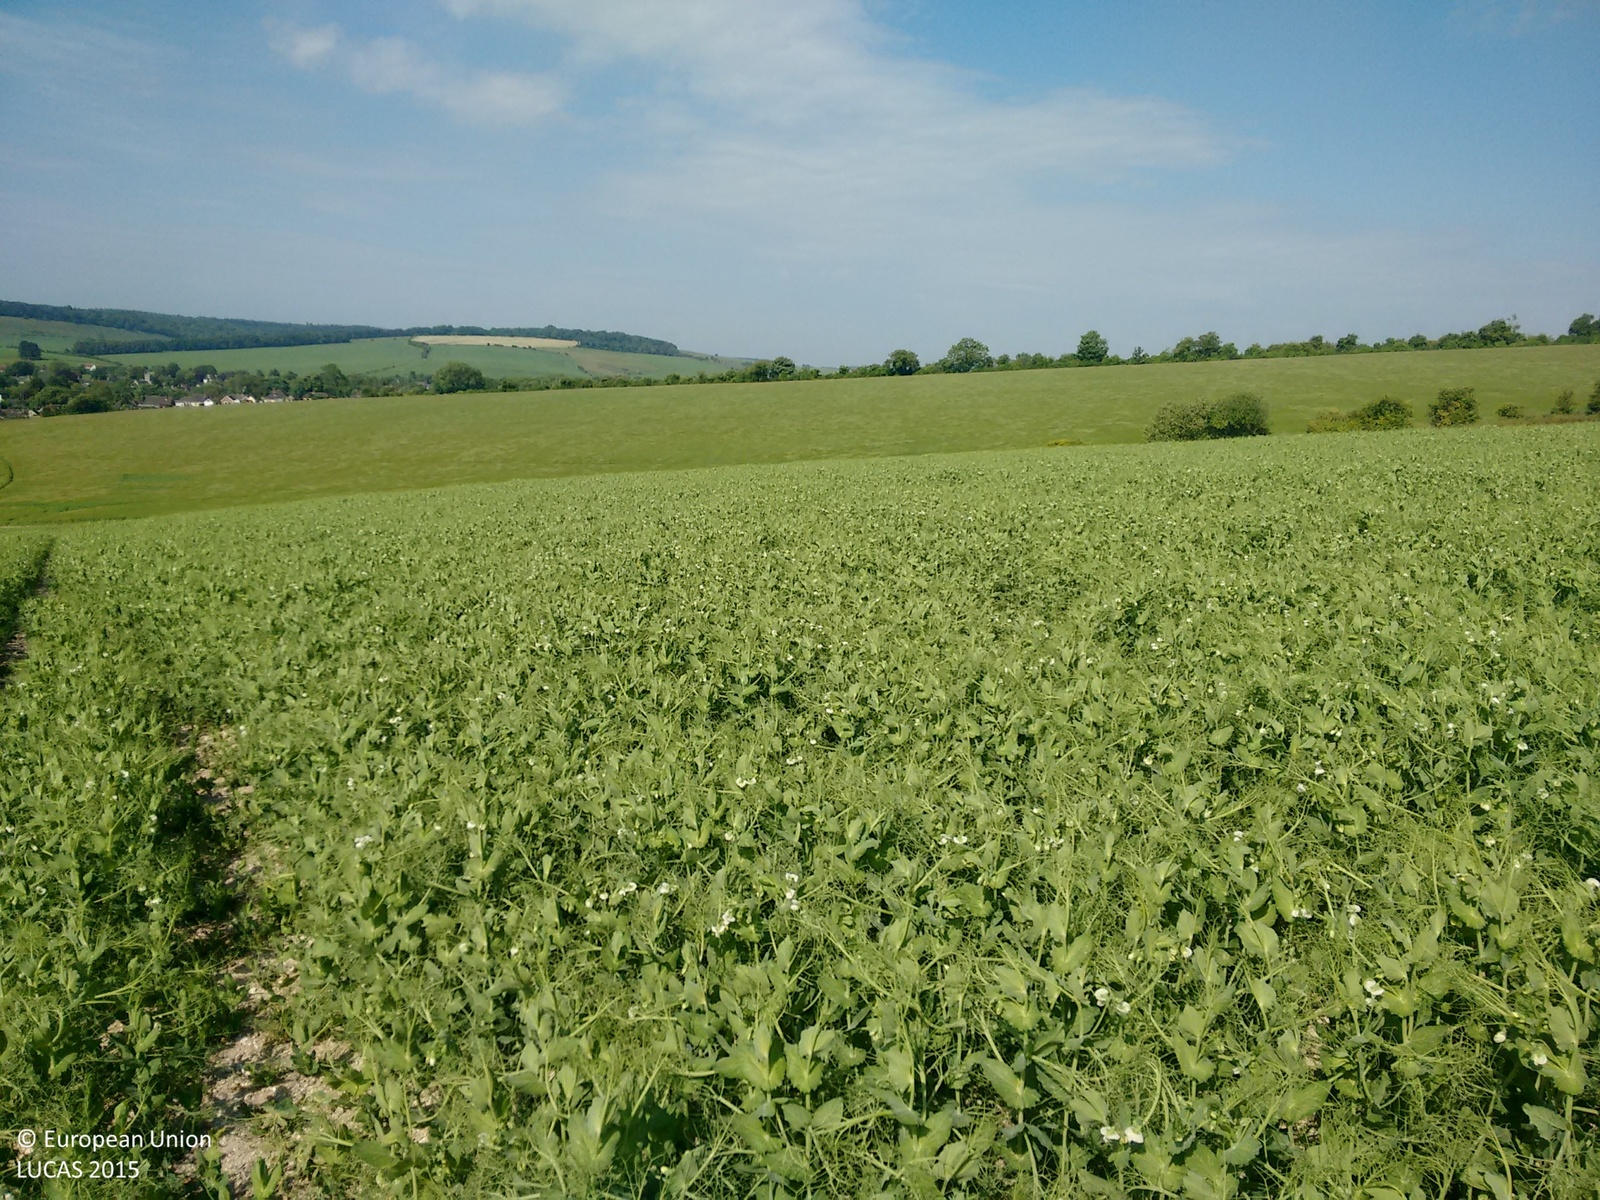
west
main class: Cropland
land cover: Dry pulses
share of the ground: > 75 %
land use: Agriculture (excluding fallow land and kitchen gardens)
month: June
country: GB
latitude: 51.1247
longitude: -1.8728
